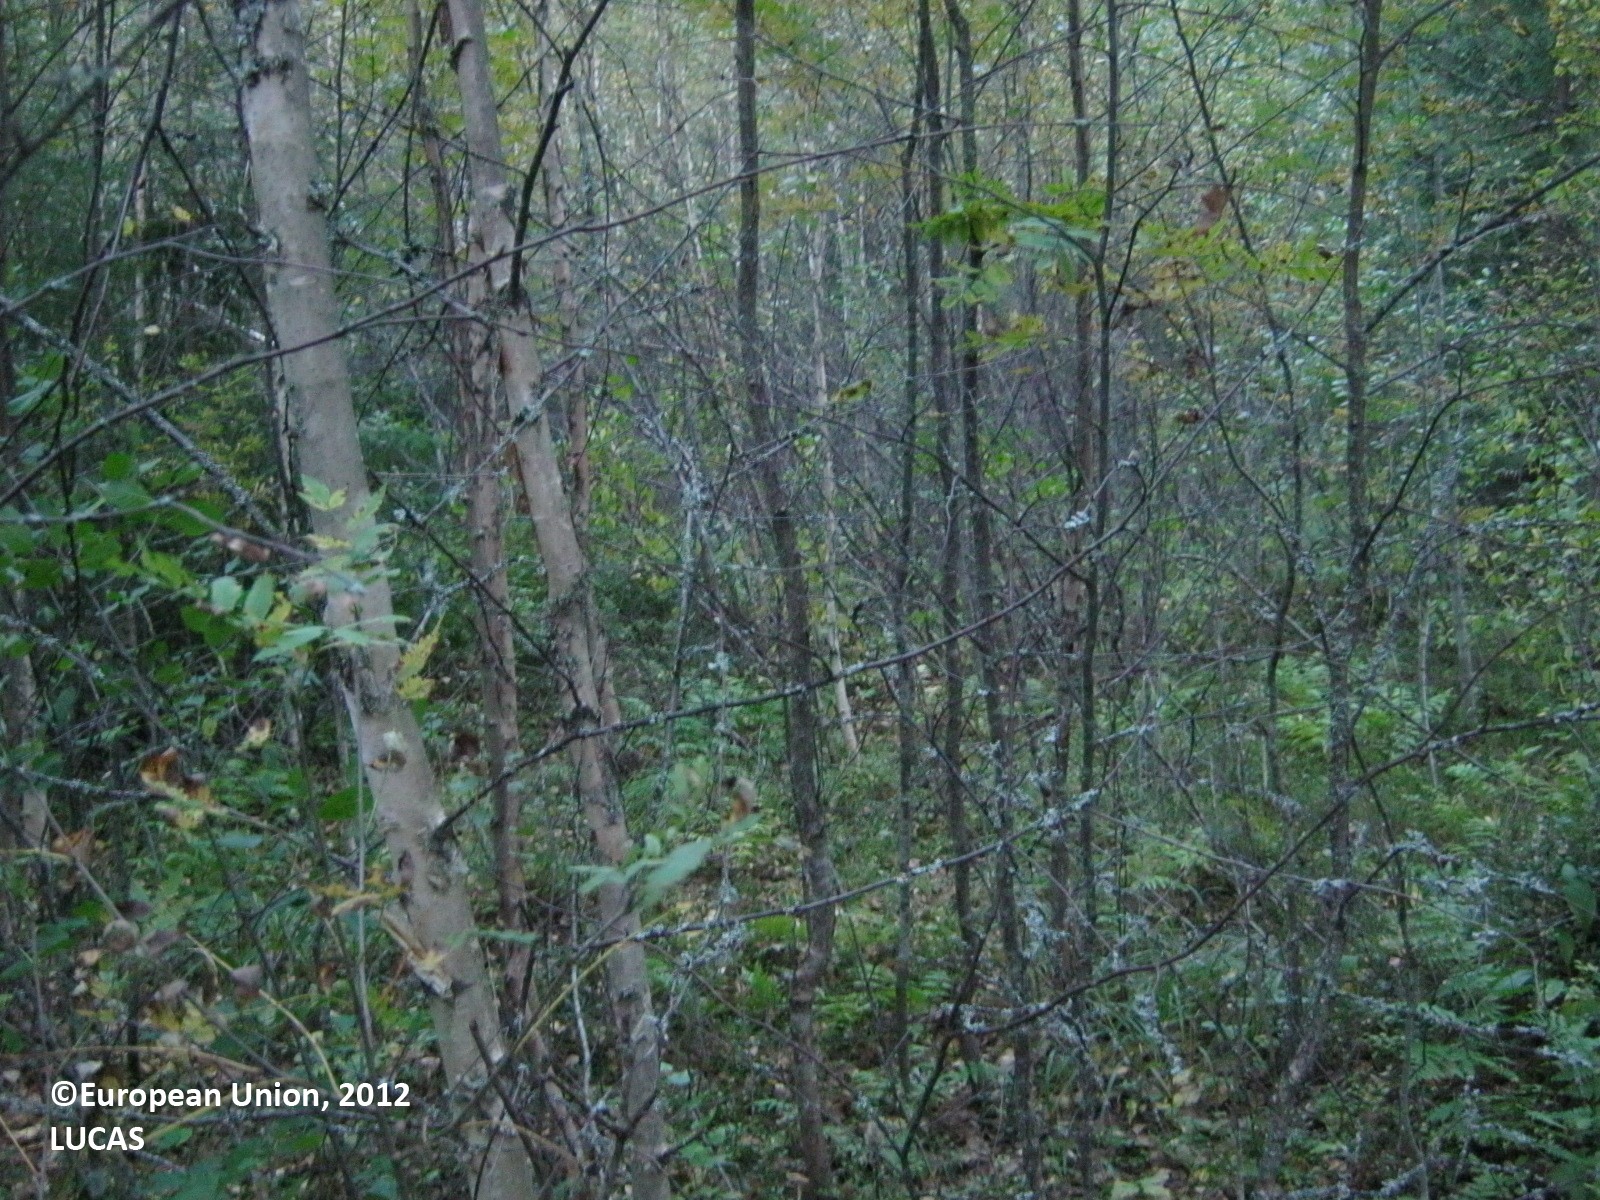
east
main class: Woodland
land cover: Broadleaved woodland
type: boreal forest
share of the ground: > 75 %
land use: Forestry
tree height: > 5 m
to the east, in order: Broadleaved woodland; Ditches and canals; Broadleaved woodland; Spruce dominated mixed woodland; Tracks; Spruce dominated mixed woodland; Spruce dominated coniferous woodland; Broadleaved woodland; Ditches and canals; Shruby margins; Tracks; Grass margins; Ditches and canals; Spruce dominated coniferous woodland
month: September
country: FI
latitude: 60.7275
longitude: 27.8900
